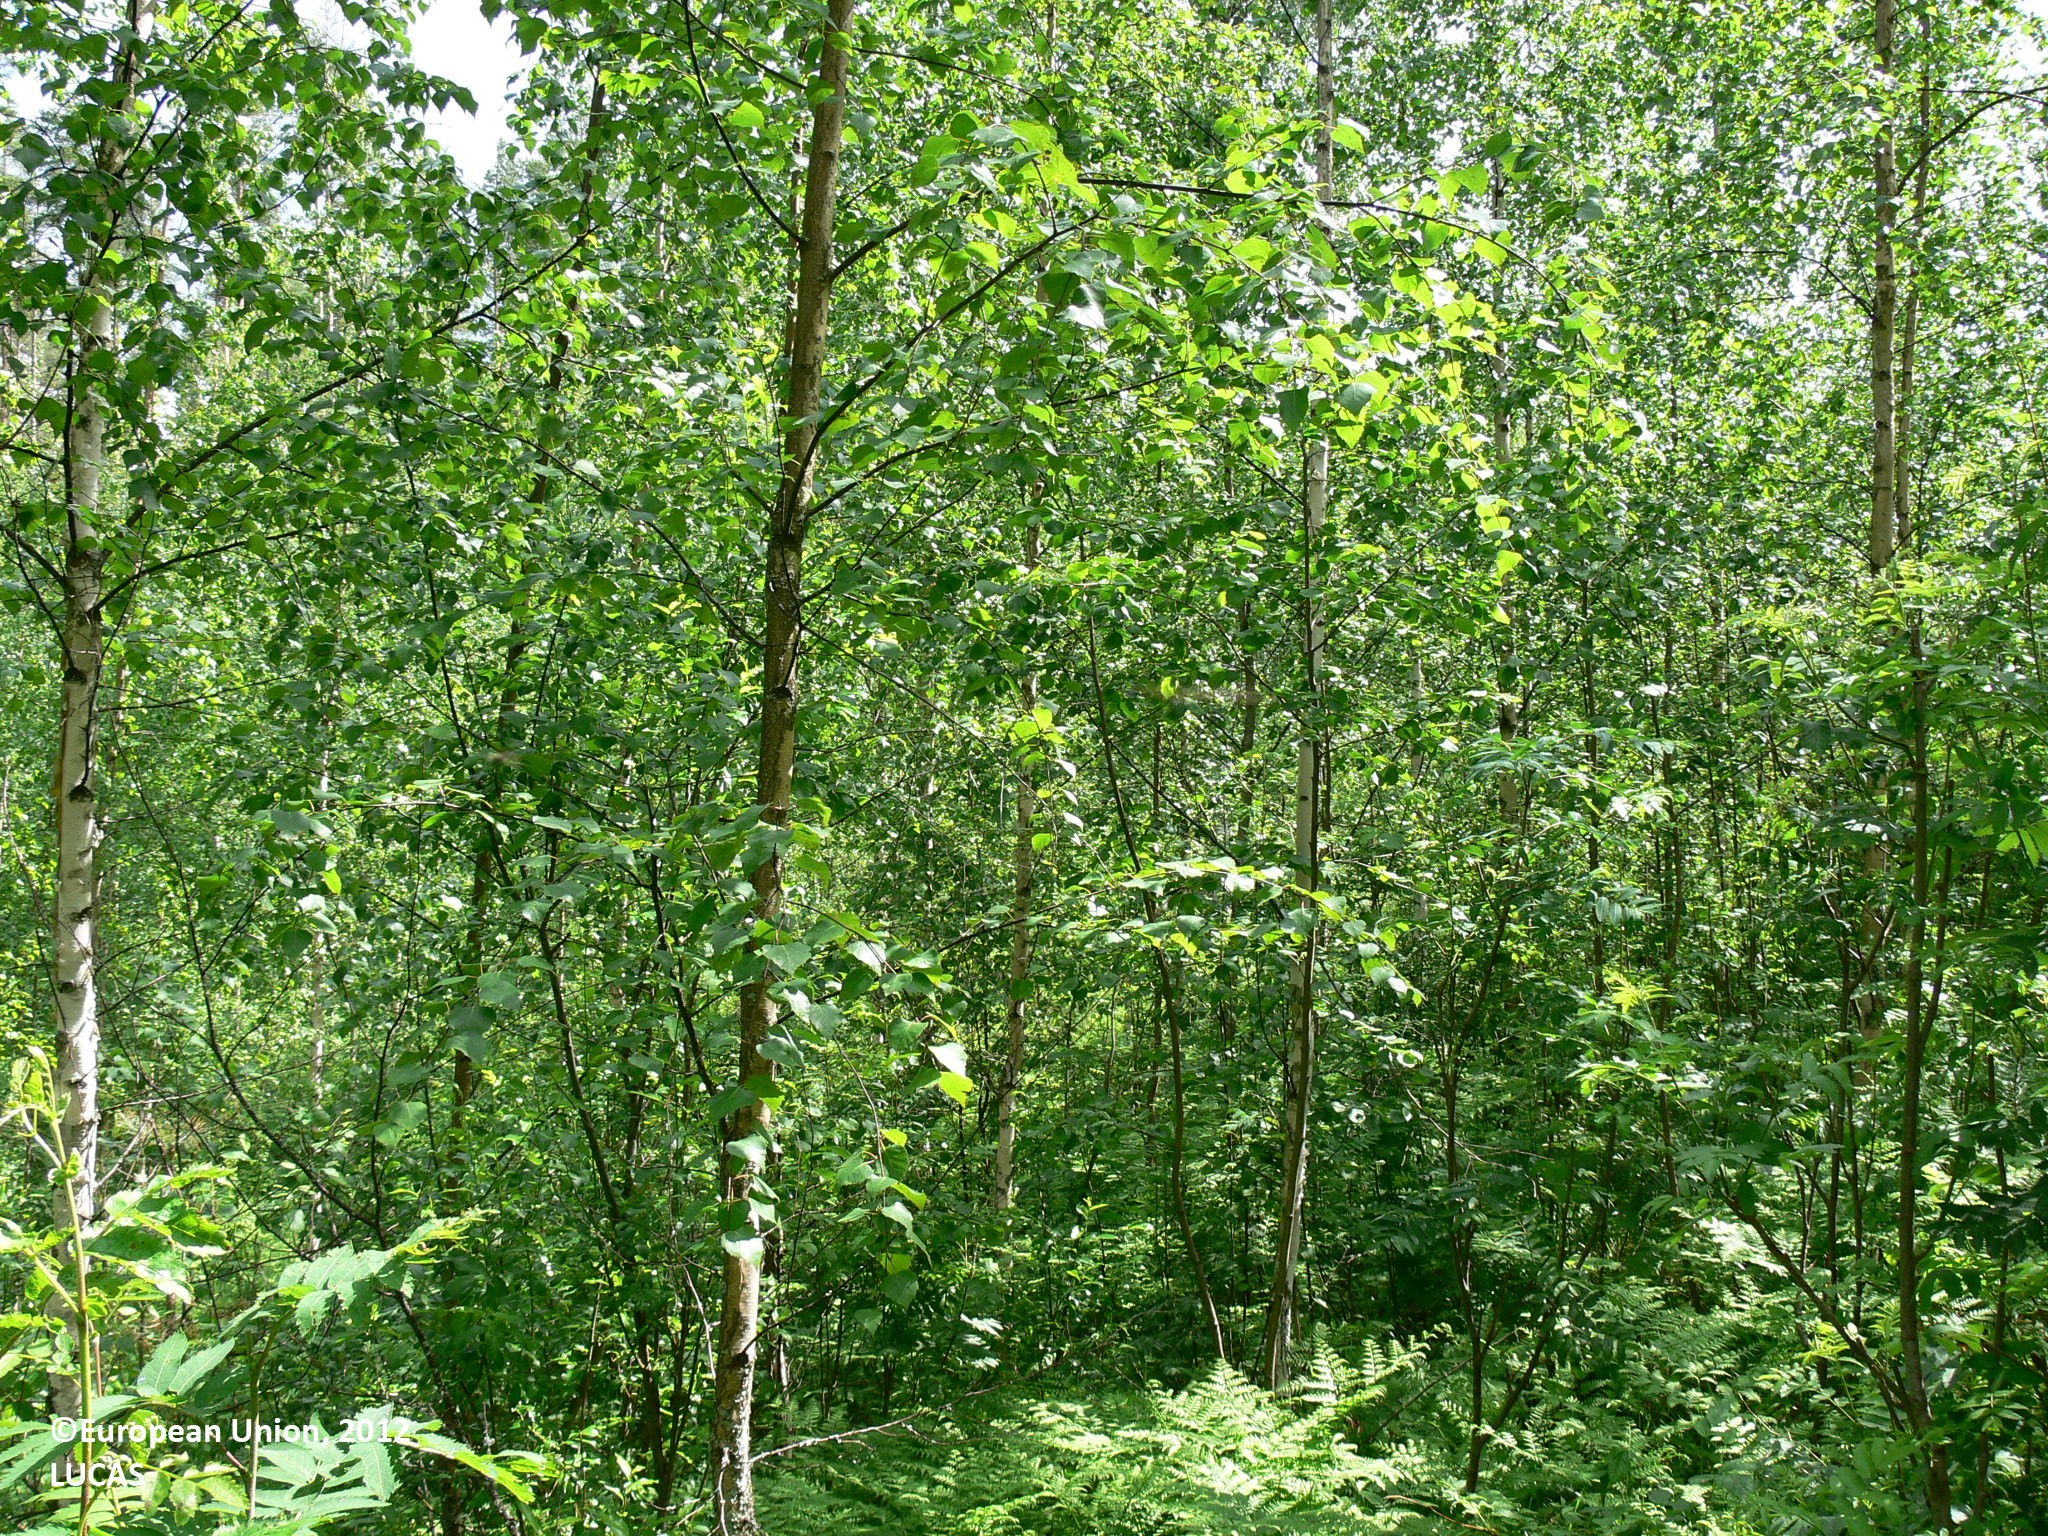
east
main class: Woodland
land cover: Broadleaved woodland
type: boreal forest
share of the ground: 50 - 75 %
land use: Forestry
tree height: > 5 m
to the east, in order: Broadleaved woodland; Spruce dominated mixed woodland; Broadleaved woodland; Other mixed woodland; Broadleaved woodland; Spruce dominated coniferous woodland; Shruby margins; Ditches and canals; Shruby margins; Paved roads, cycling and walking lanes; Grass margins; Spruce dominated coniferous woodland
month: June
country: FI
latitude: 62.3329
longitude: 30.1327
